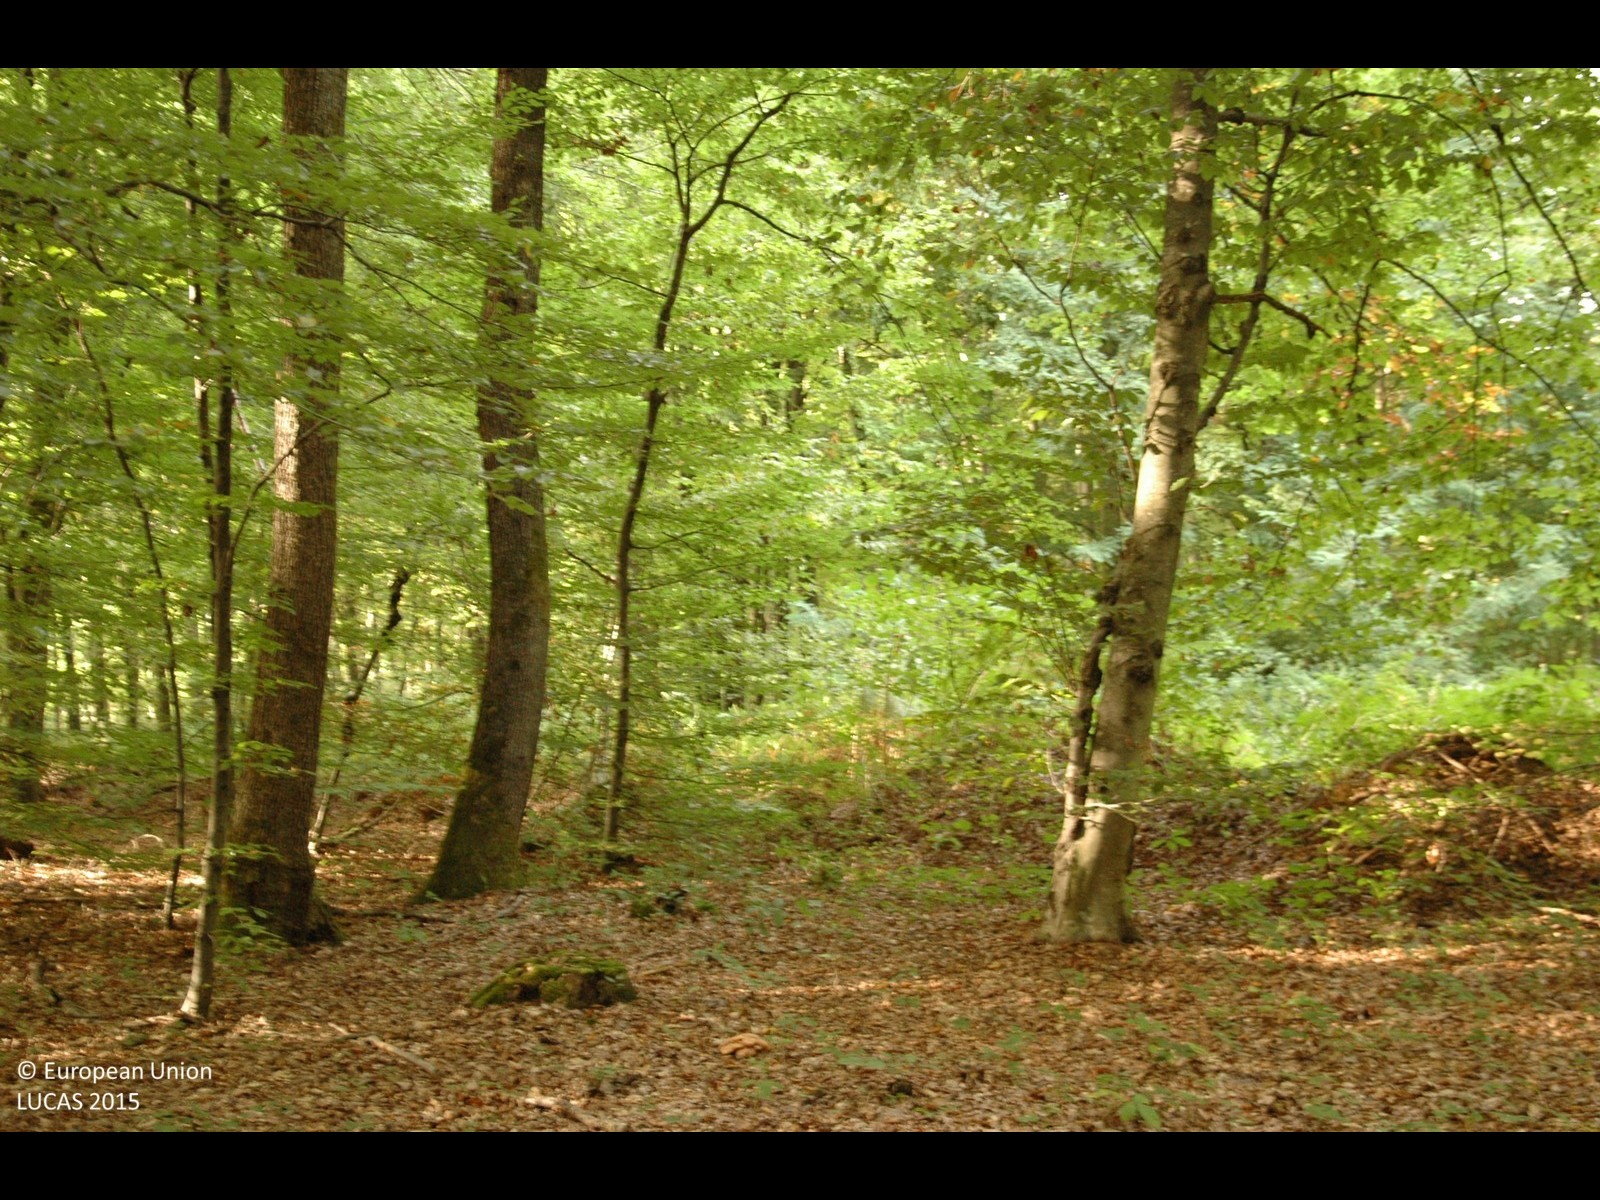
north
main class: Woodland
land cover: Broadleaved woodland
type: mesophytic deciduous forest
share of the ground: > 75 %
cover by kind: broadleaved forest trees 100 %
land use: Forestry
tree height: > 5 m
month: September
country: HR
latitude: 45.6501
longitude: 15.8356
